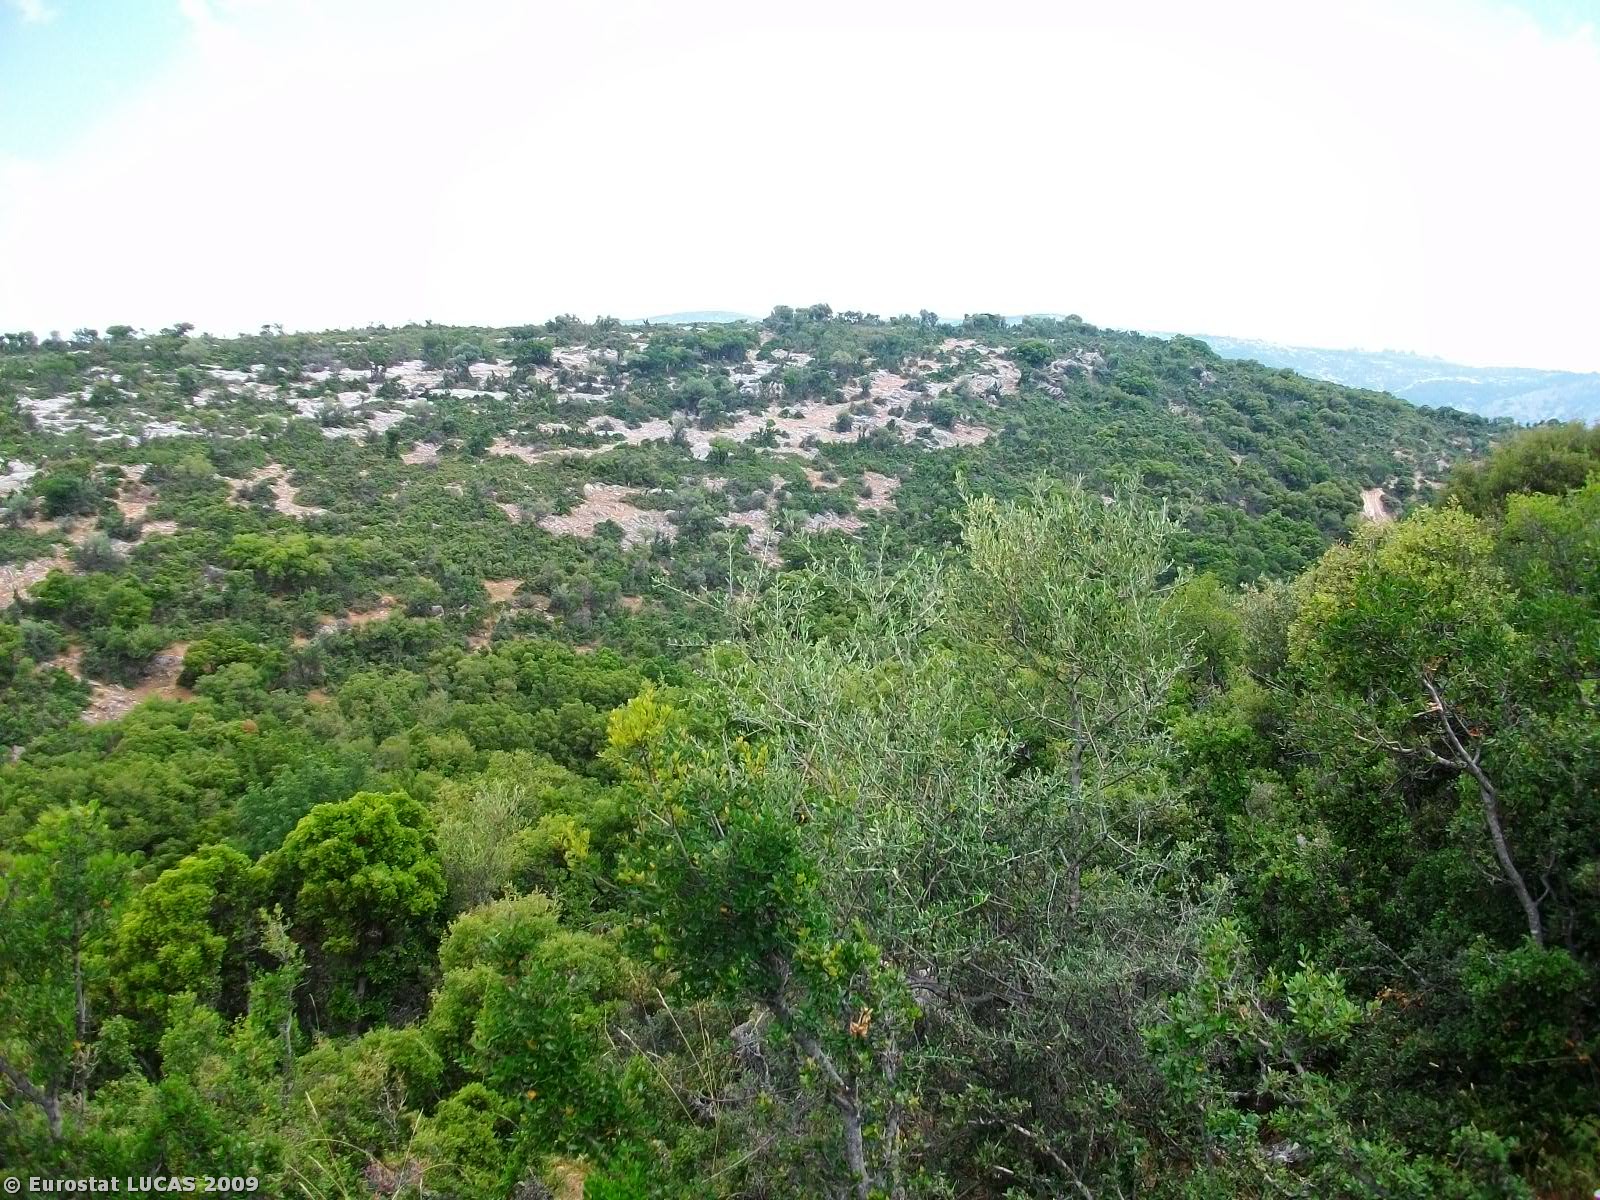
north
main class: Shrubland
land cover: Shrubland without tree cover
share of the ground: > 75 %
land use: Agriculture (excluding fallow land and kitchen gardens)
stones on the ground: > 50 %
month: June
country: GR
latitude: 39.5077
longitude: 22.8672
